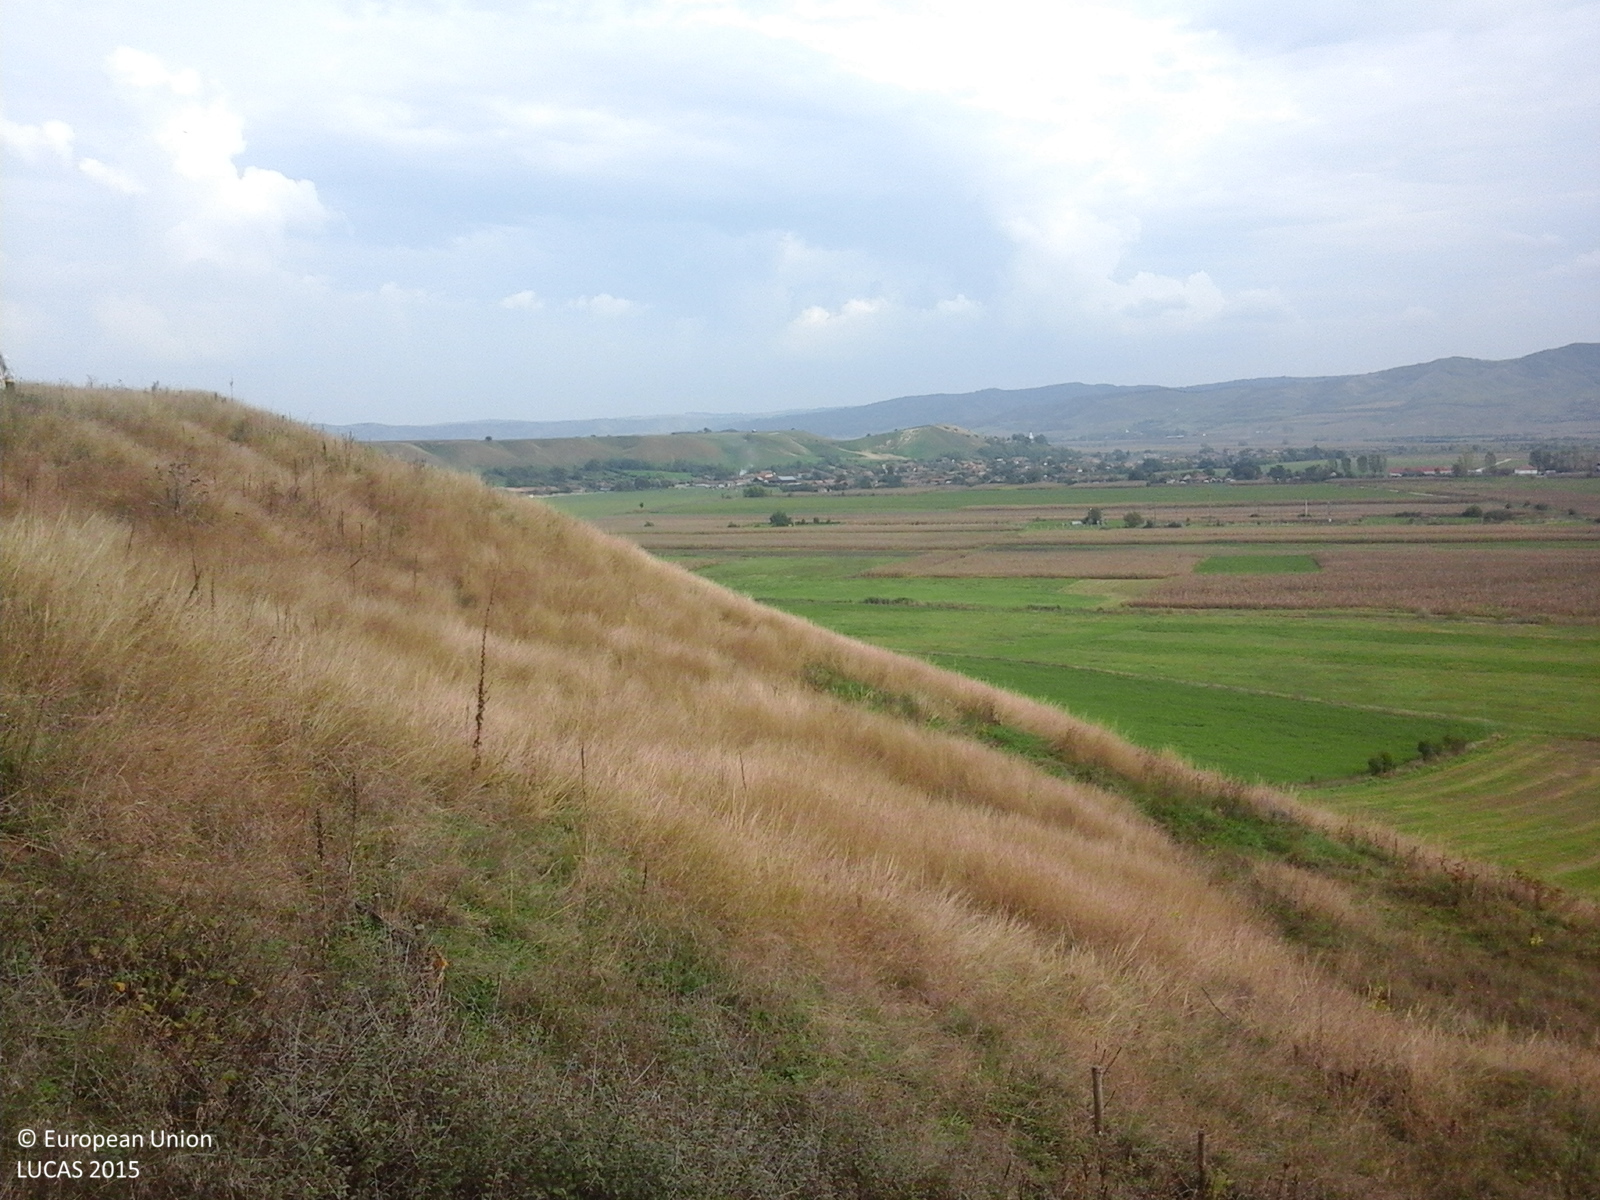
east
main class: Grassland
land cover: Grassland with sparse tree/shrub cover
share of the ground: > 75 %
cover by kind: herbaceous plants 95 %, broadleaved forest trees 5 %
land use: Agriculture (excluding fallow land and kitchen gardens)
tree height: < 5 m
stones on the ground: < 10 %
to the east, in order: Grassland with sparse tree/shrub cover
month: October
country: RO
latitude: 46.4380
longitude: 23.9368
